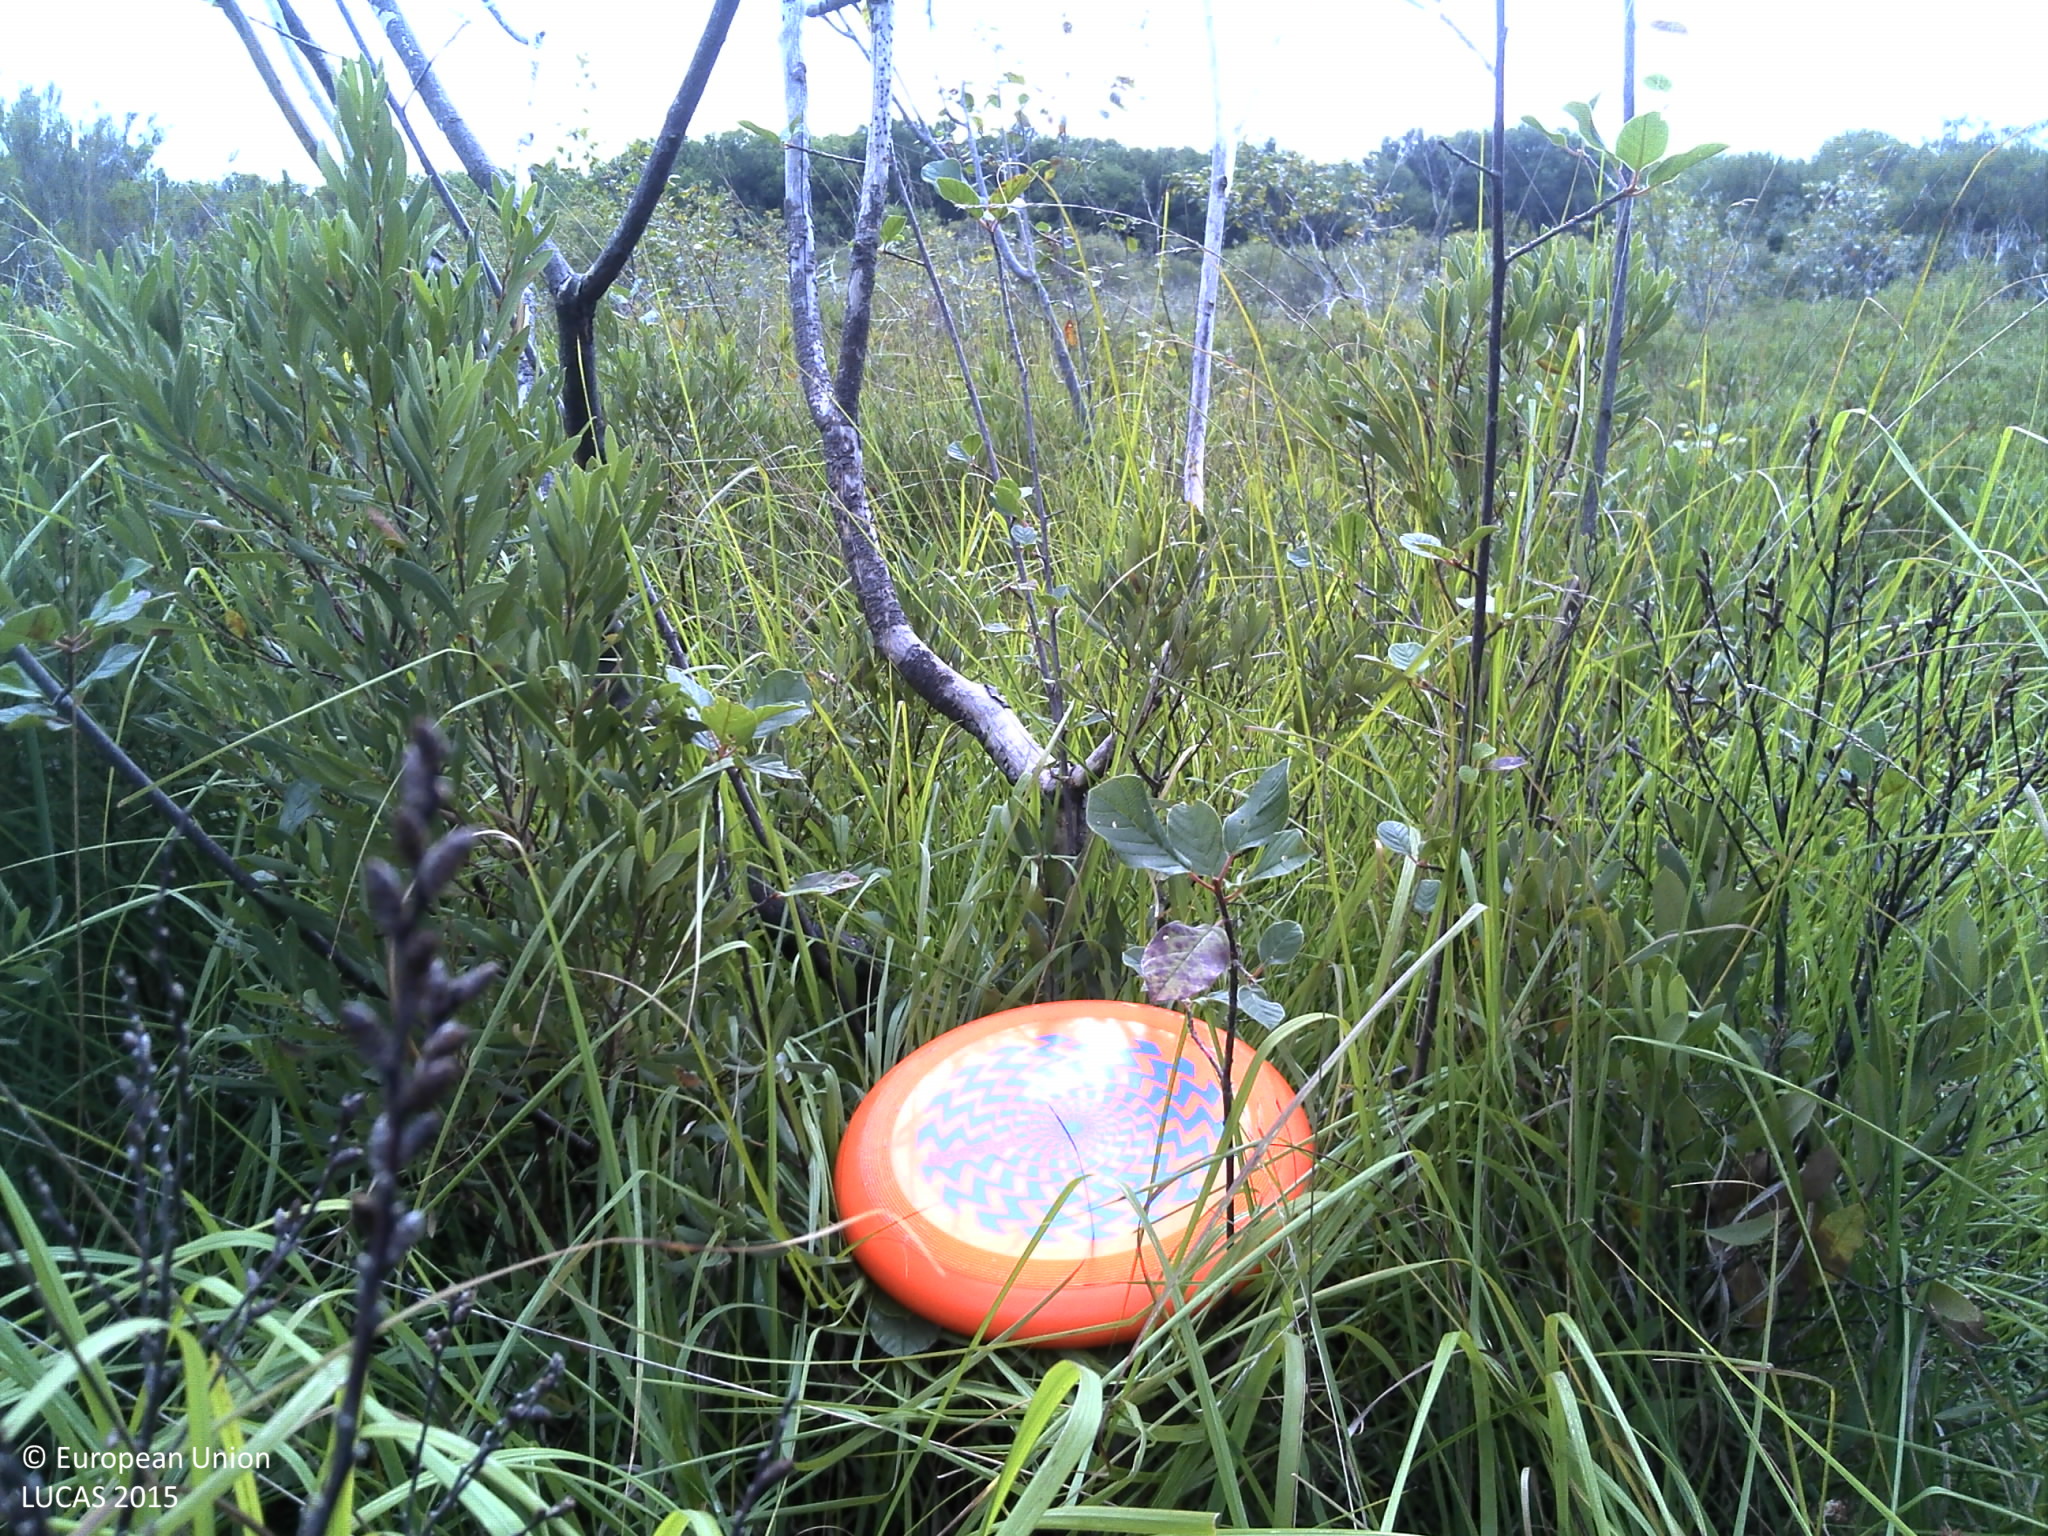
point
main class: Shrubland
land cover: Shrubland without tree cover
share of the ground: > 75 %
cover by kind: shrubs 80 %, herbaceous plants 20 %
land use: Semi-natural and natural areas not in use
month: August
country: FR
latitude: 44.6216
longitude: -0.9732
